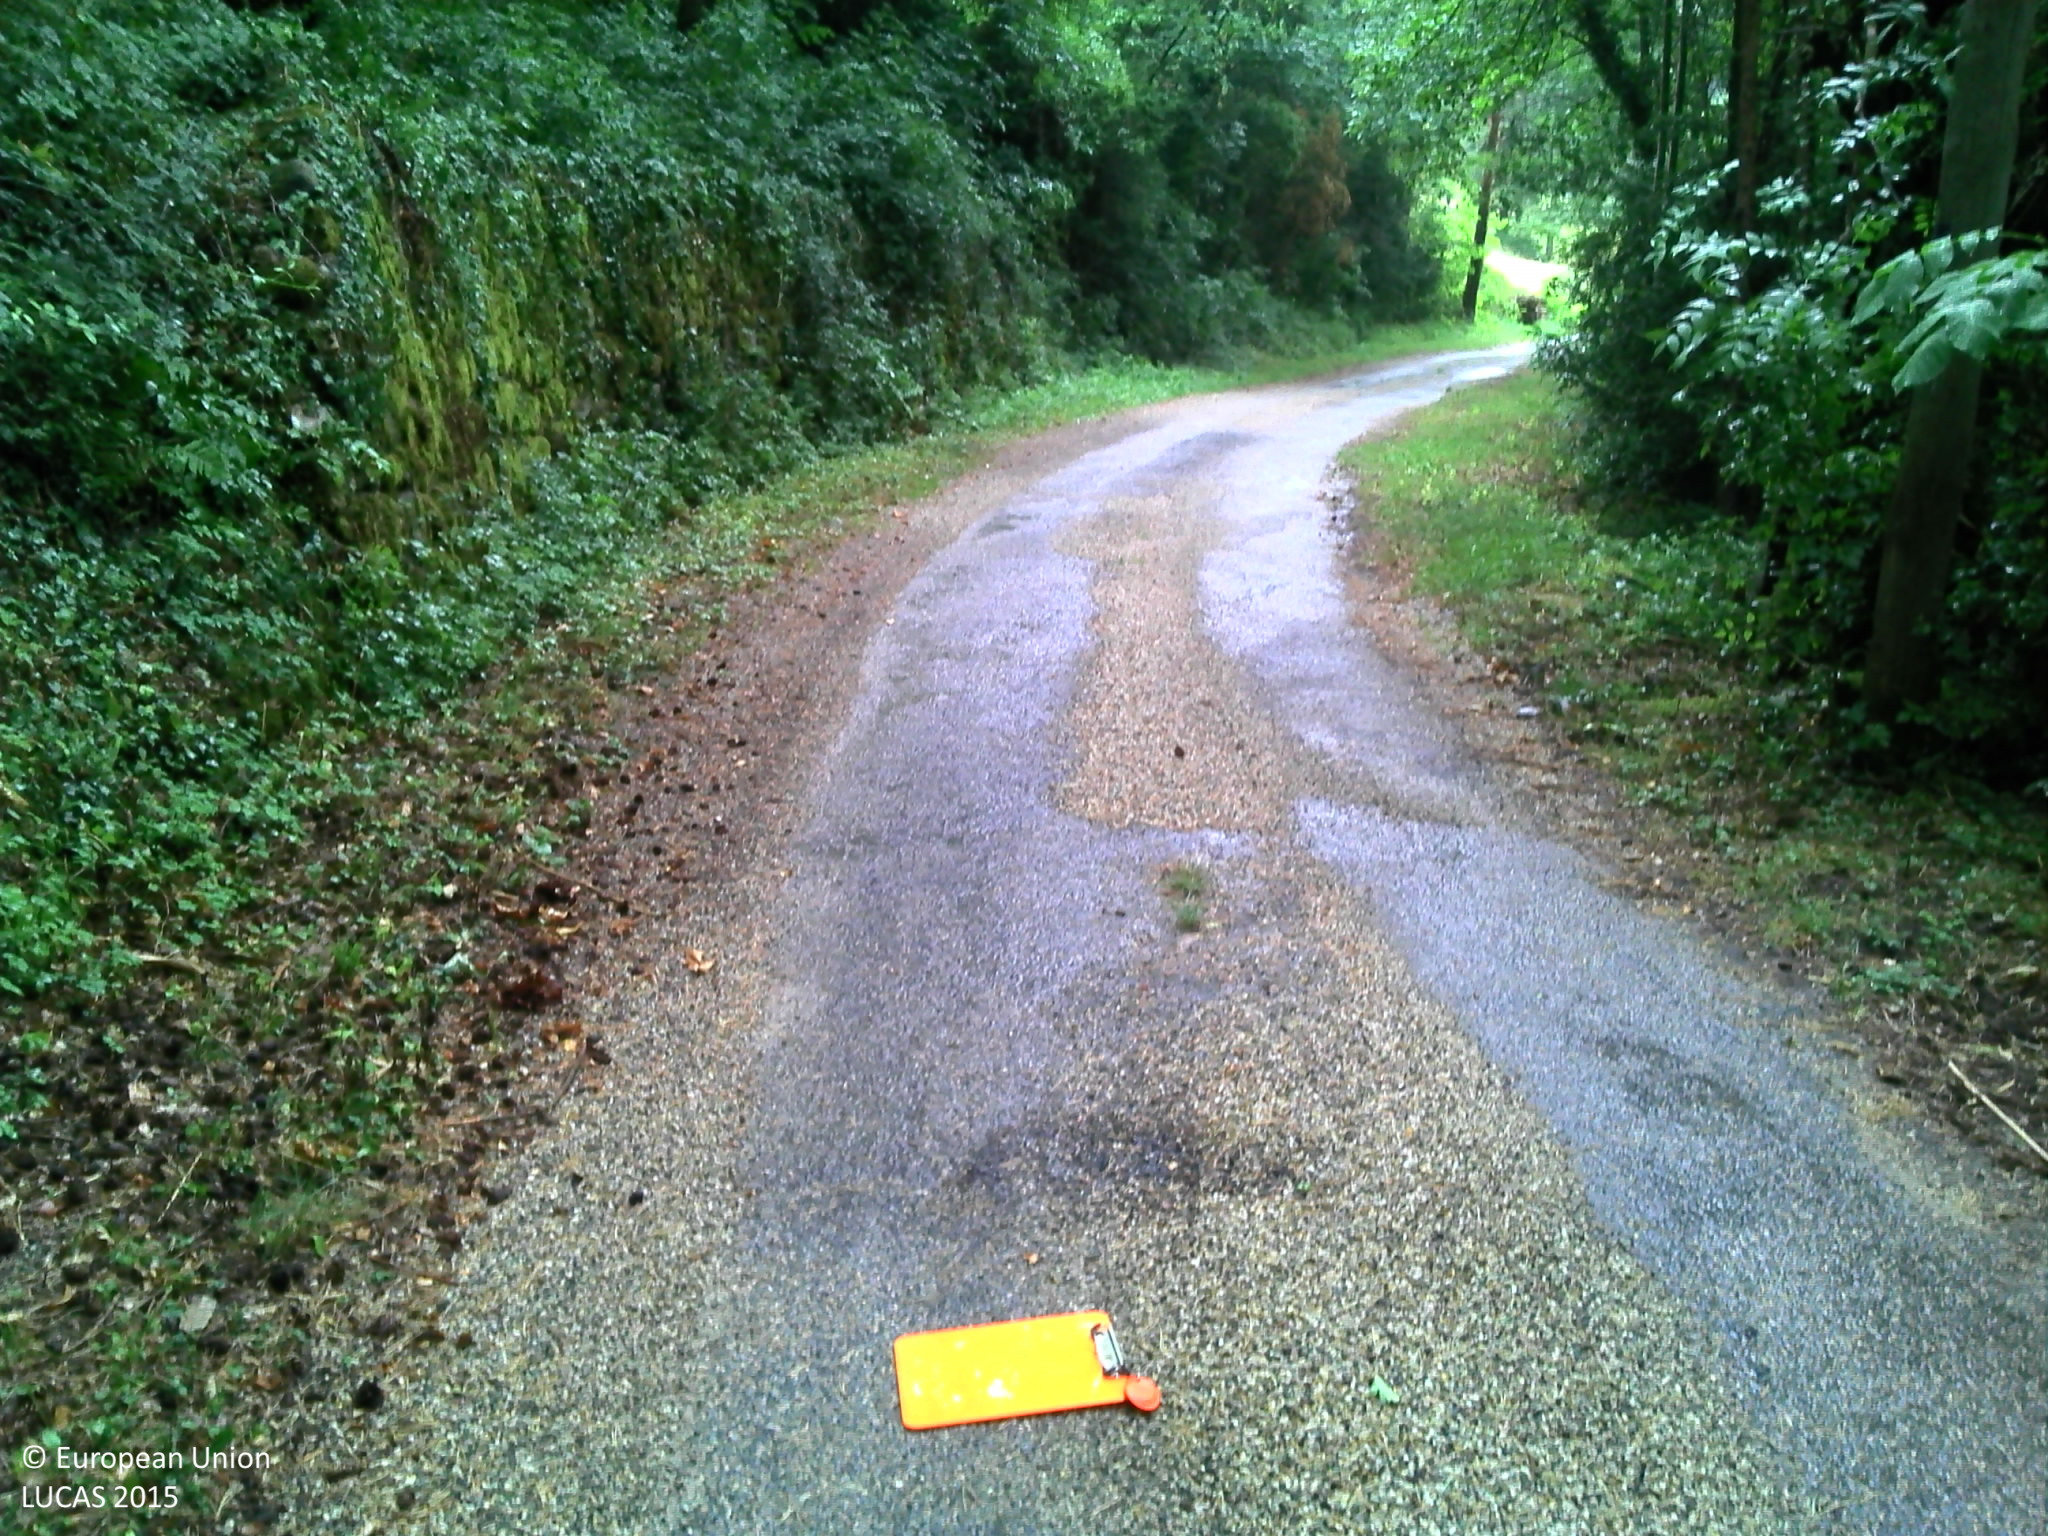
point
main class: Woodland
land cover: Pine dominated mixed woodland
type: mountainous beech forest
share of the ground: > 75 %
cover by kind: broadleaved forest trees 50 %, coniferous forest trees 25 %, herbaceous plants 25 %
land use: Semi-natural and natural areas not in use
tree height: > 5 m
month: July
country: FR
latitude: 44.7887
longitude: 4.6089
